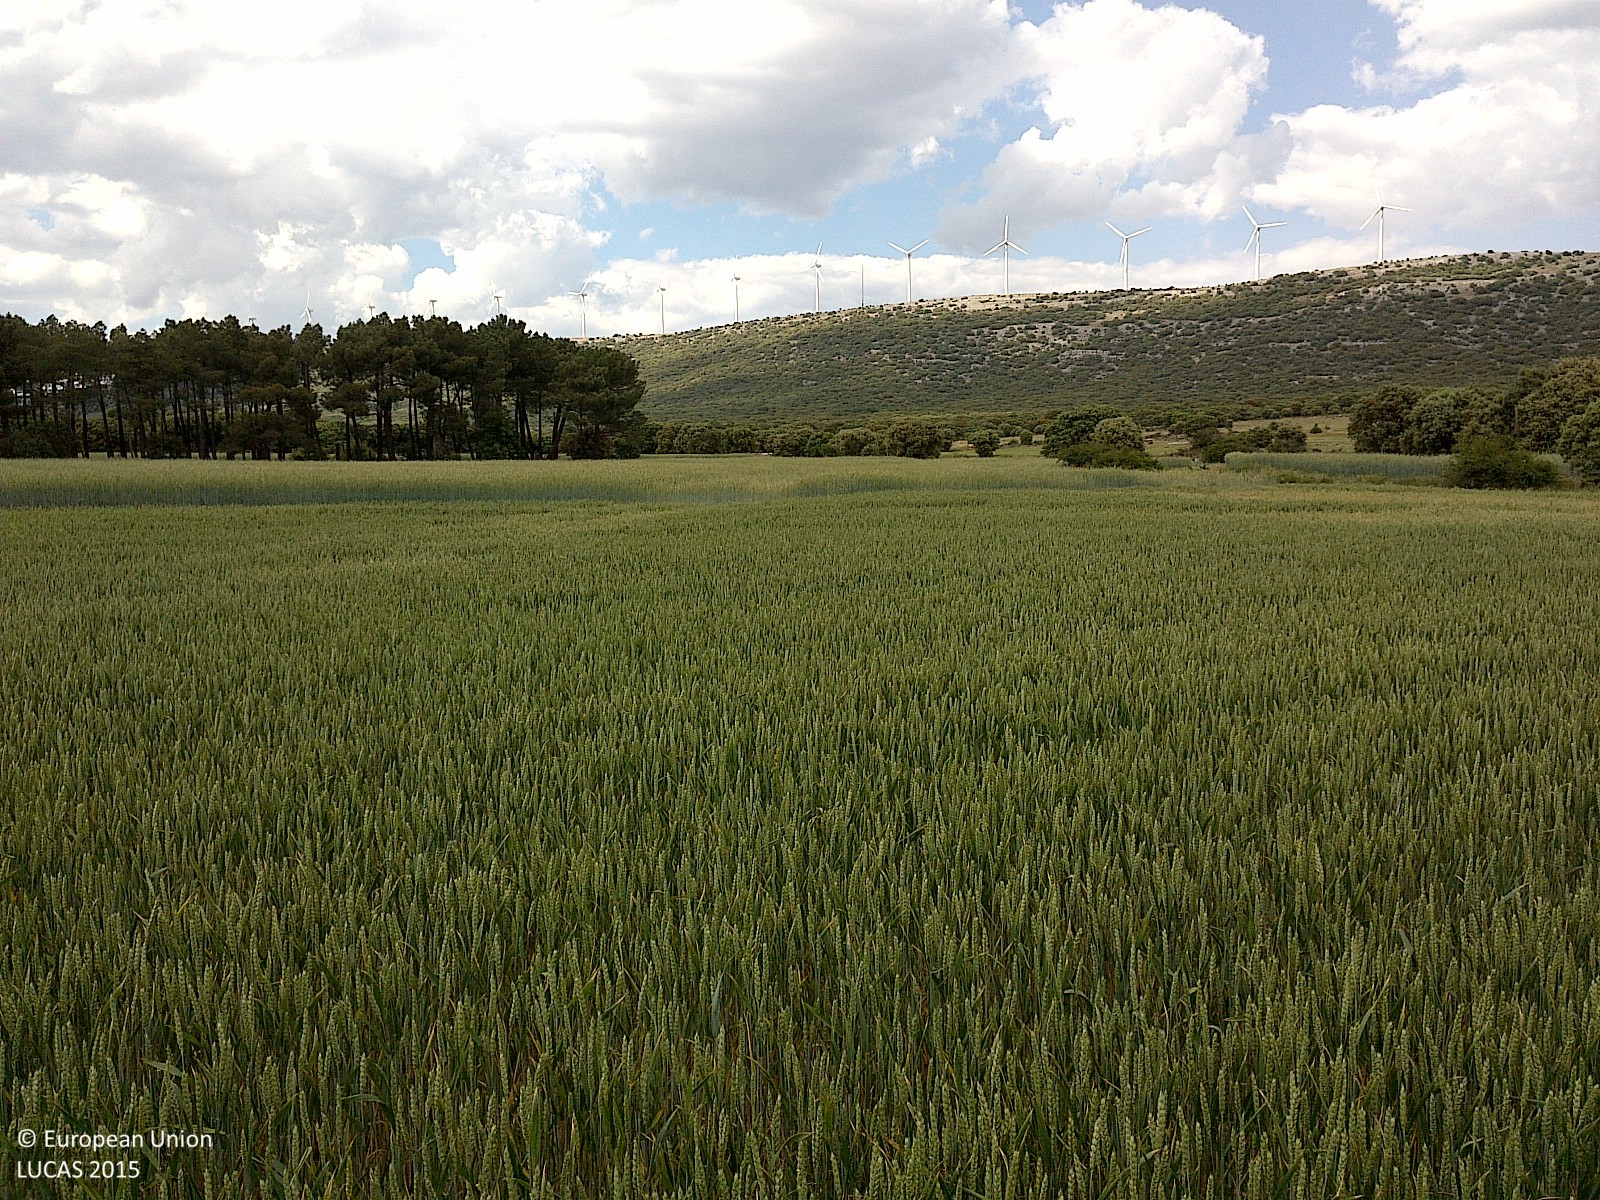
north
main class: Cropland
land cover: Common wheat
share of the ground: > 75 %
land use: Agriculture (excluding fallow land and kitchen gardens)
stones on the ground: < 10 %
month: June
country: ES
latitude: 41.7324
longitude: -2.1894
